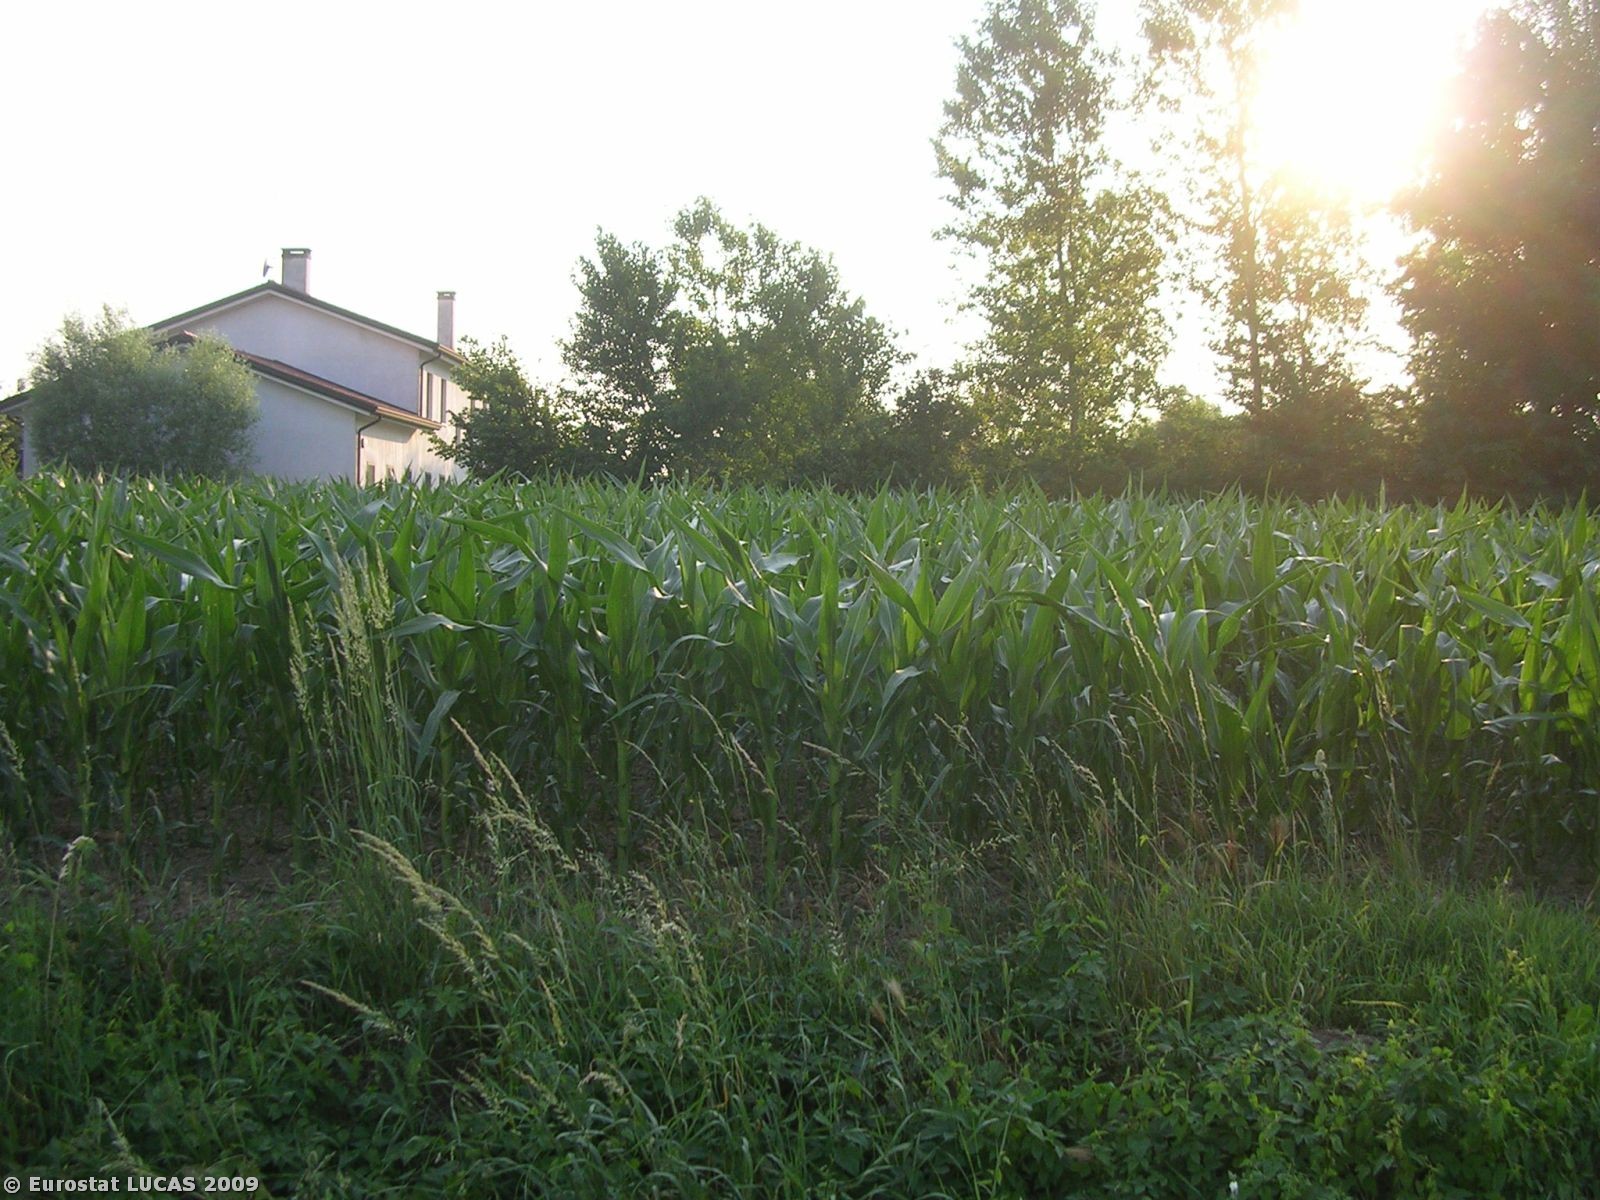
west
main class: Cropland
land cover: Maize
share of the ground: > 75 %
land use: Agriculture (excluding fallow land and kitchen gardens)
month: June
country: IT
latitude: 45.5745
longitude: 12.0600
